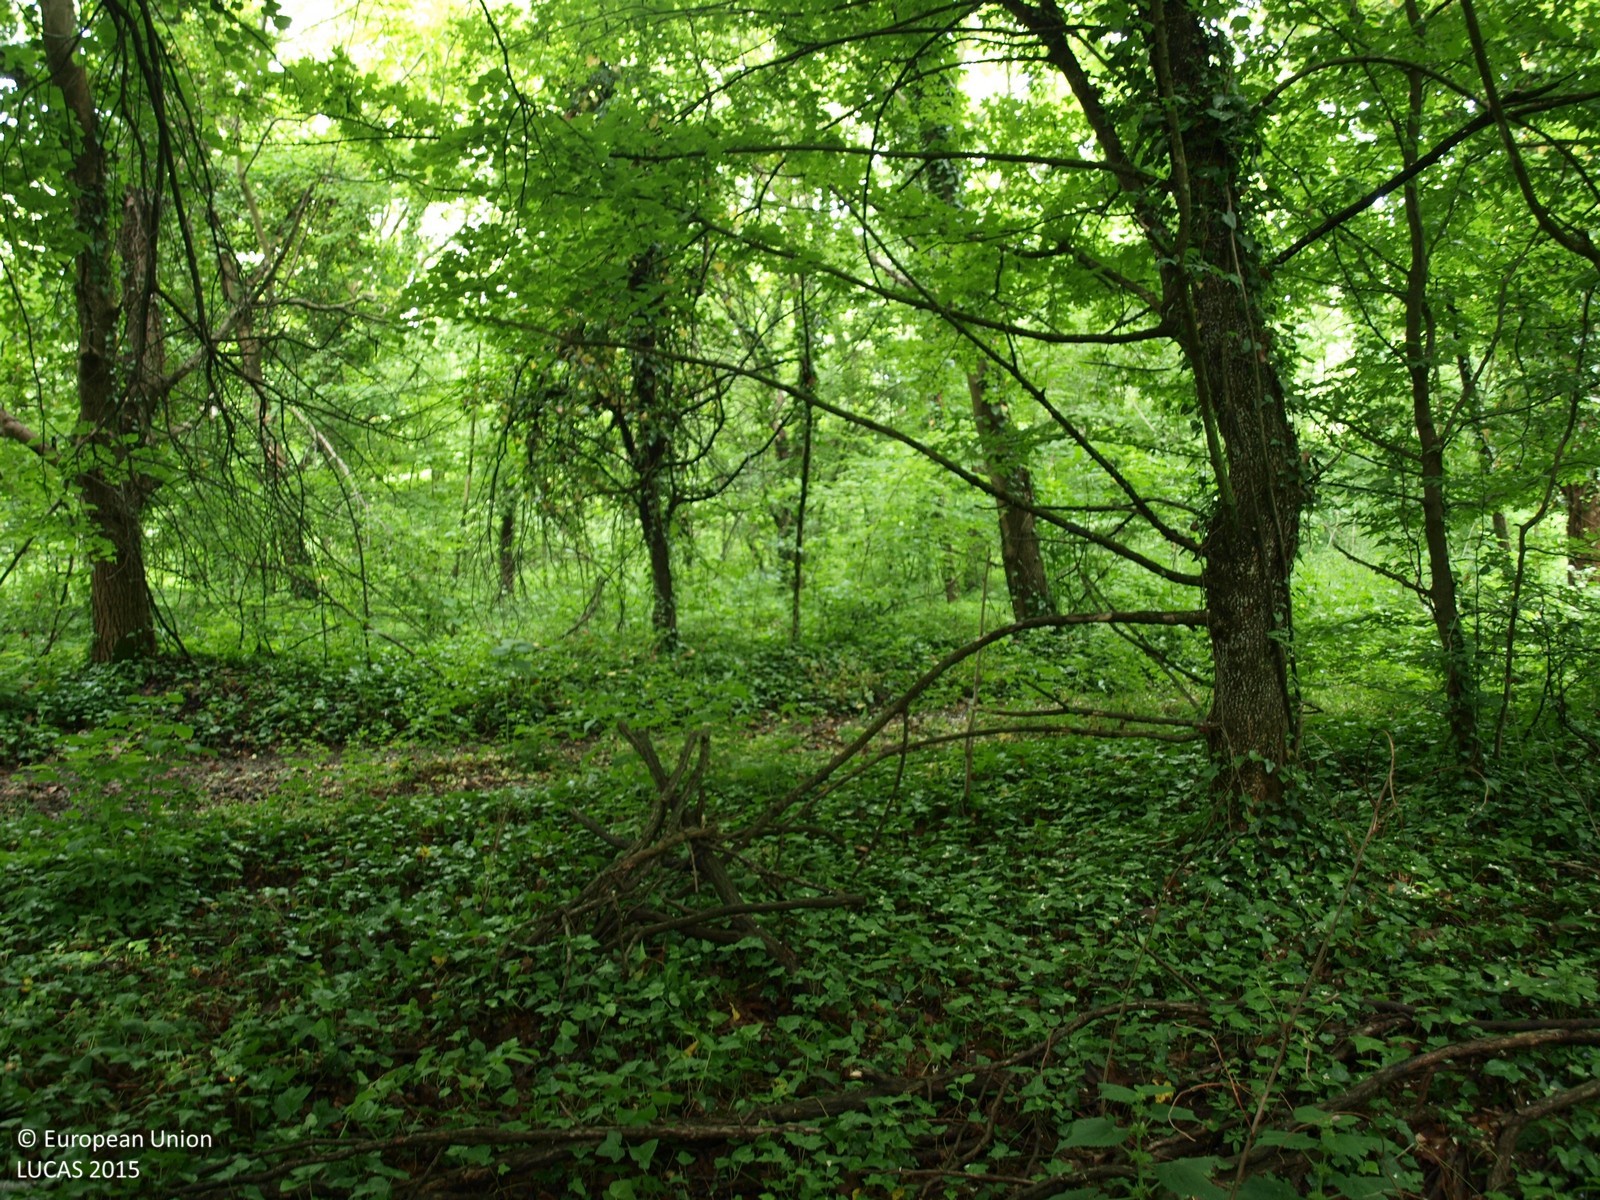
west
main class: Woodland
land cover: Broadleaved woodland
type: mesophytic deciduous forest
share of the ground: > 75 %
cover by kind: broadleaved forest trees 95 %, herbaceous plants 5 %
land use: Forestry
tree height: > 5 m
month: May
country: HR
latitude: 46.0993
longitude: 16.1953
